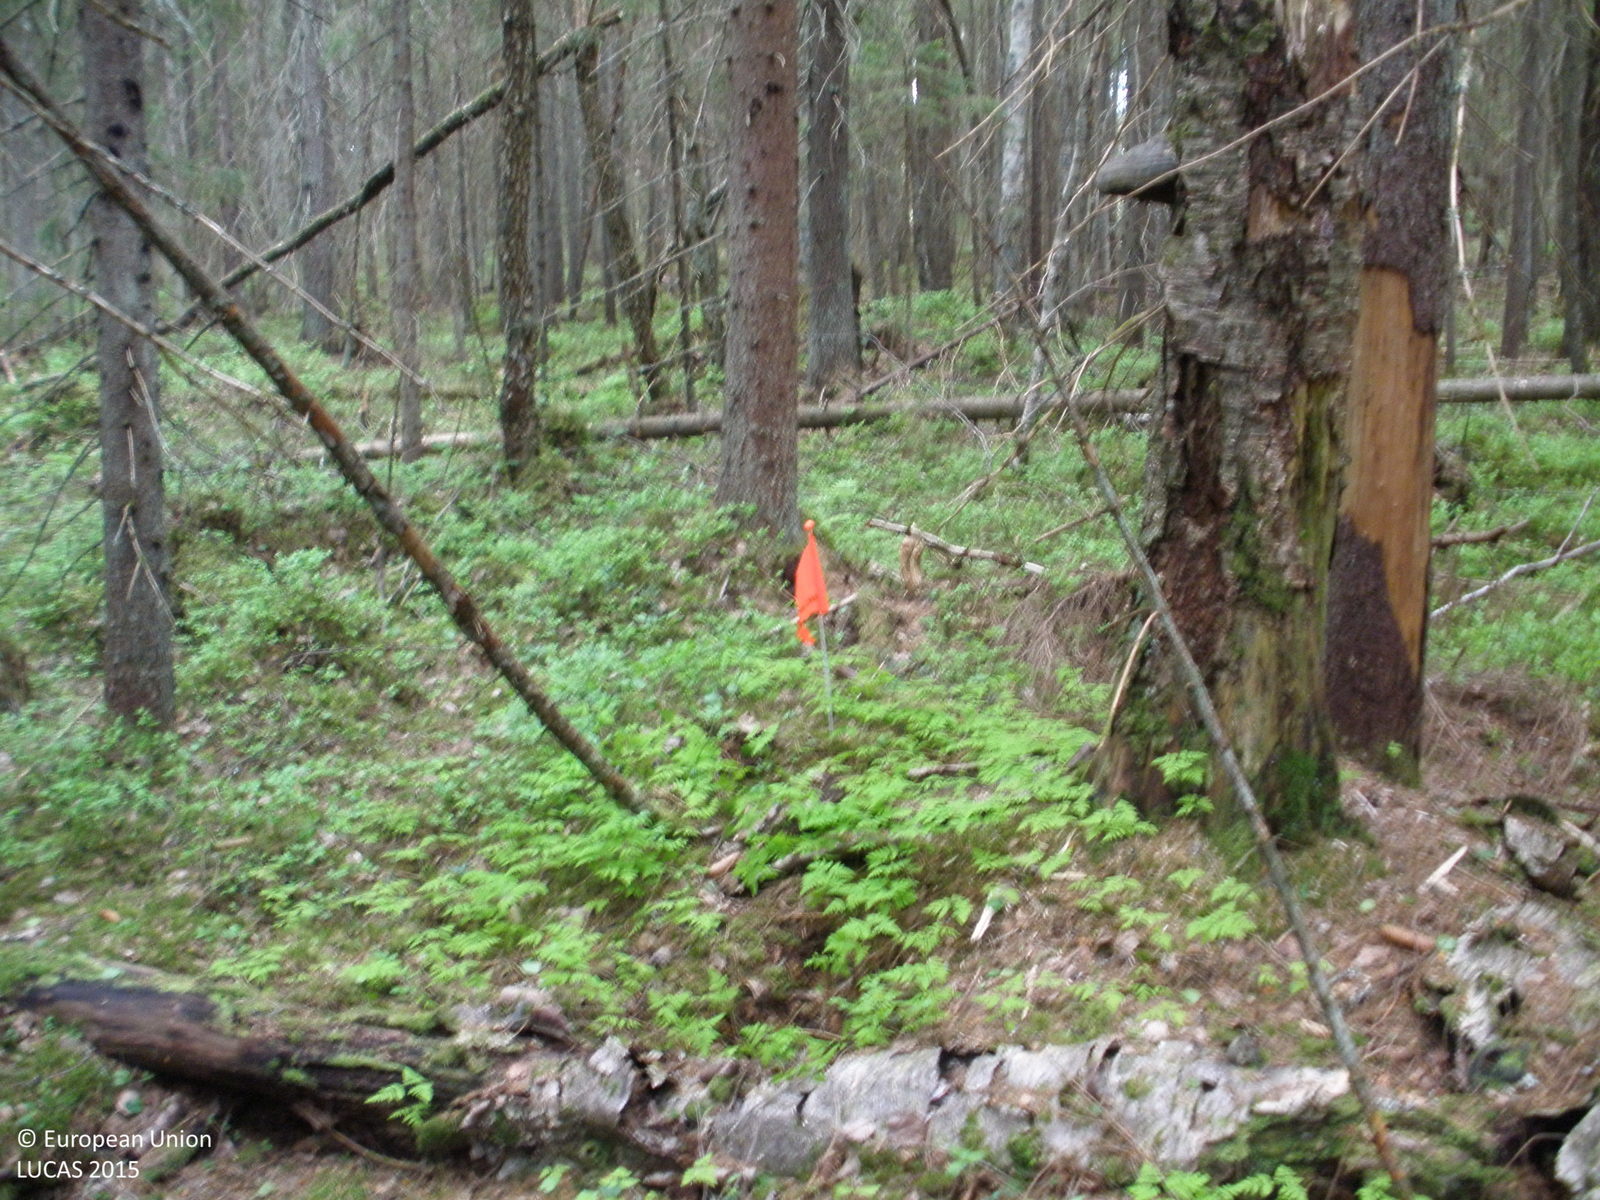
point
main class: Woodland
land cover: Spruce dominated mixed woodland
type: boreal forest
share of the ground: > 75 %
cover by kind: coniferous forest trees 65 %, broadleaved forest trees 25 %, shrubs 5 %, herbaceous plants 5 %
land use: Forestry
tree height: > 5 m
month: June
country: FI
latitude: 60.7234
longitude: 24.0084
